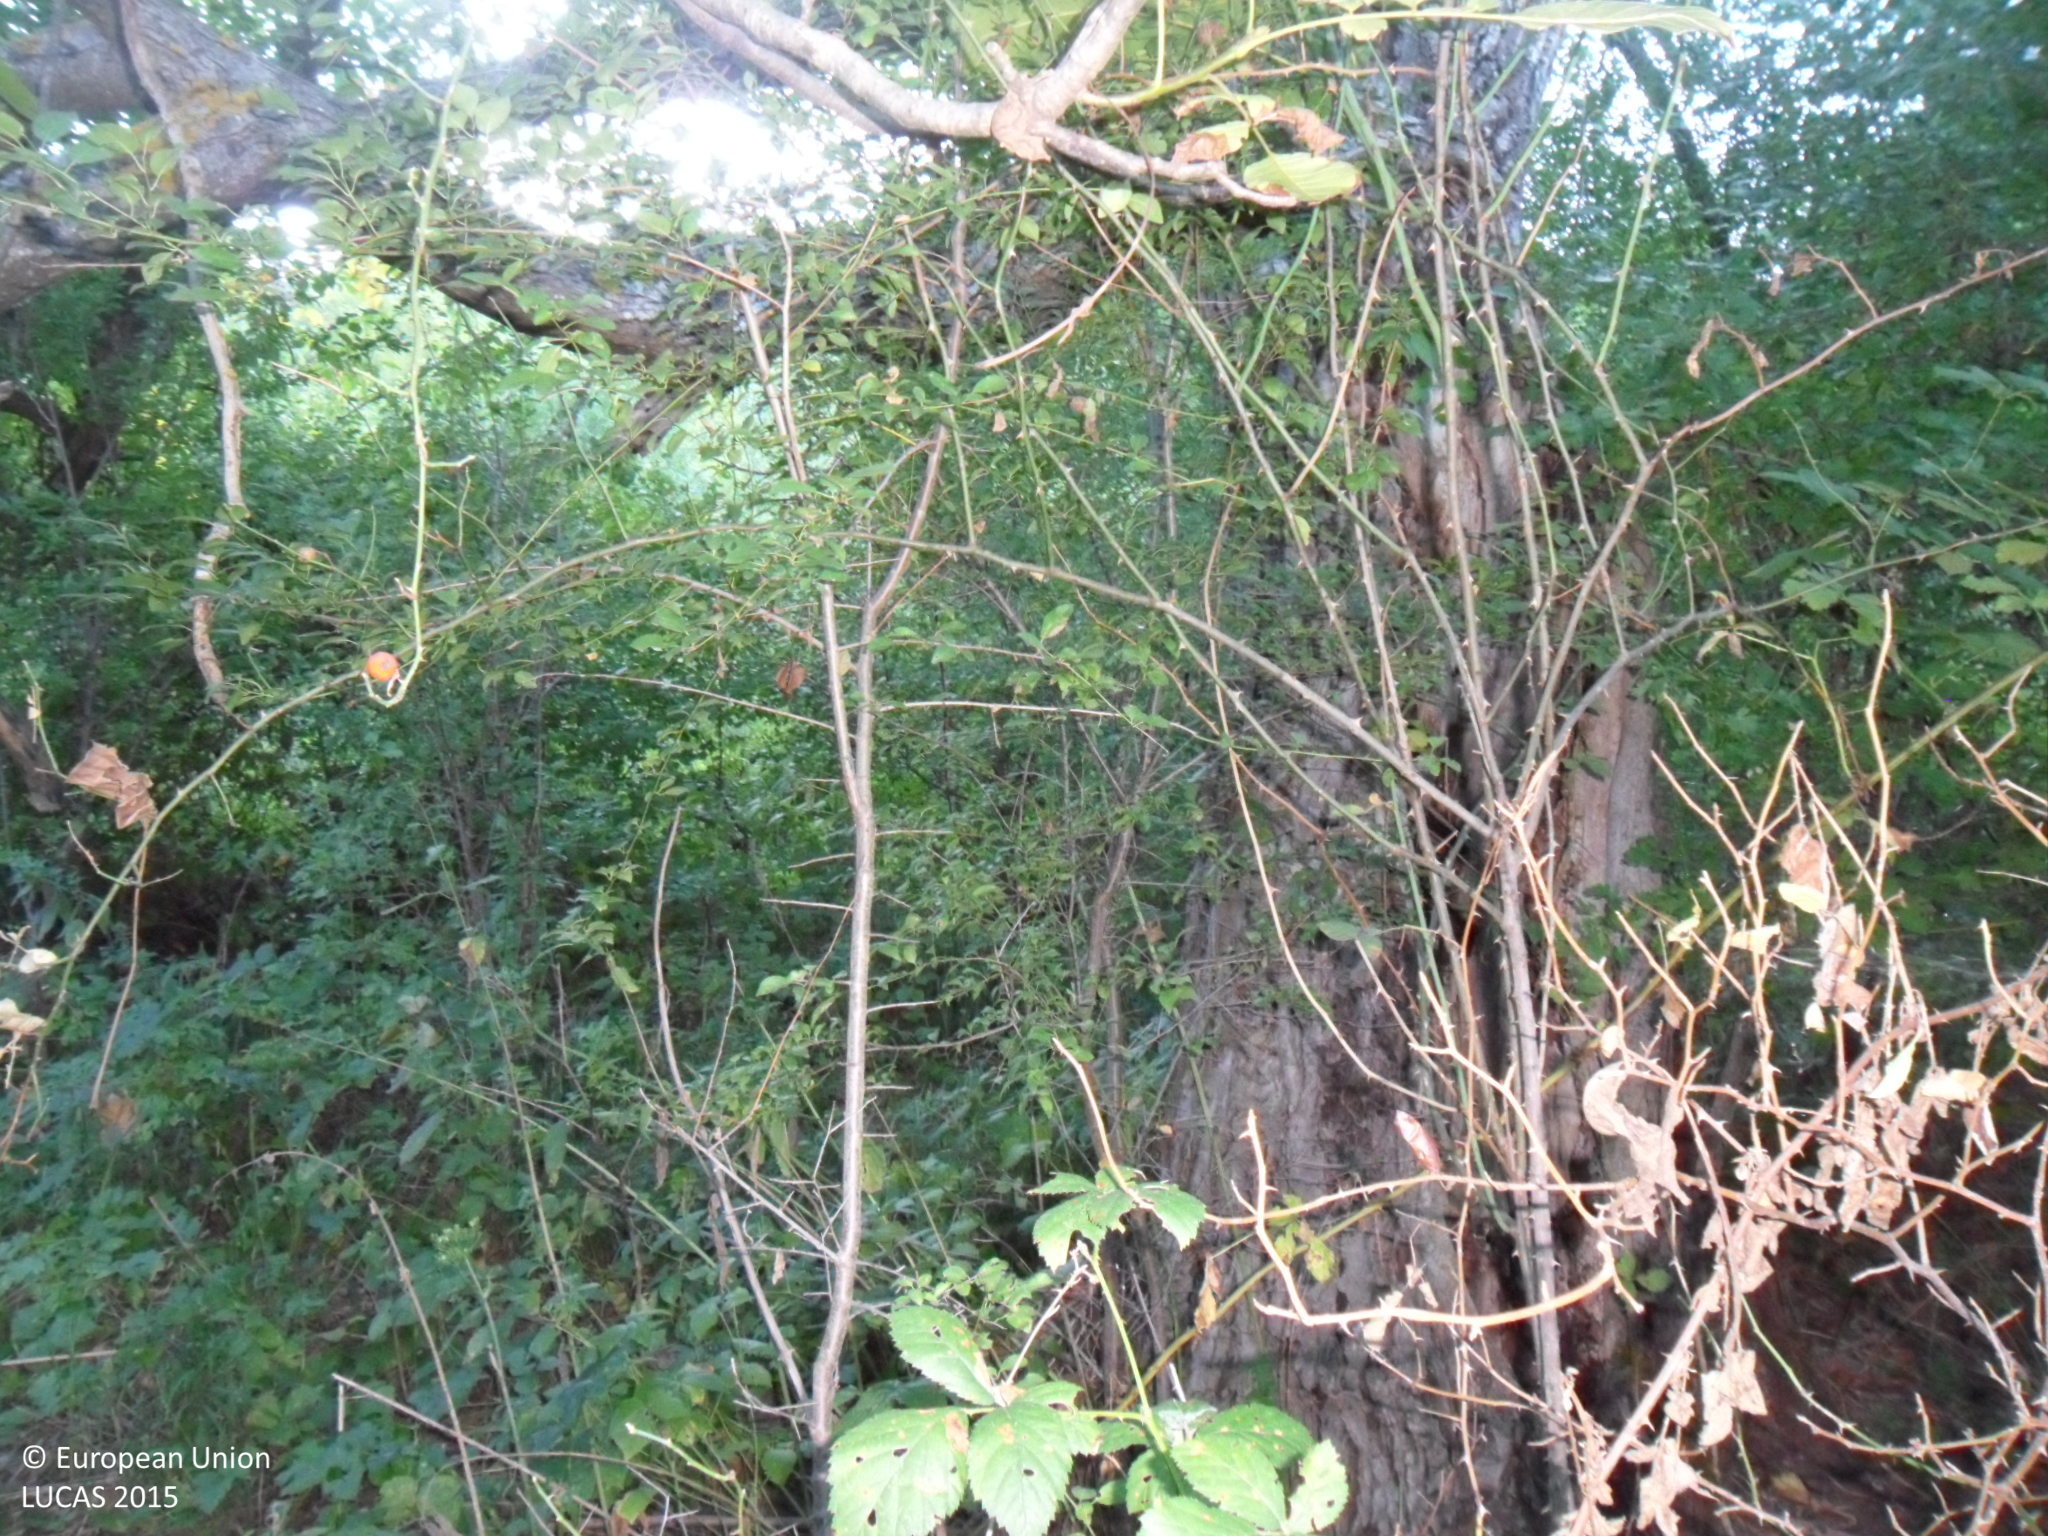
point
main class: Woodland
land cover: Broadleaved woodland
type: mesophytic deciduous forest
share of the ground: 50 - 75 %
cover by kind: broadleaved forest trees 60 %, shrubs 30 %, herbaceous plants 10 %
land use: Forestry
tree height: > 5 m
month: September
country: BG
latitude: 43.1616
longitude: 26.7473
